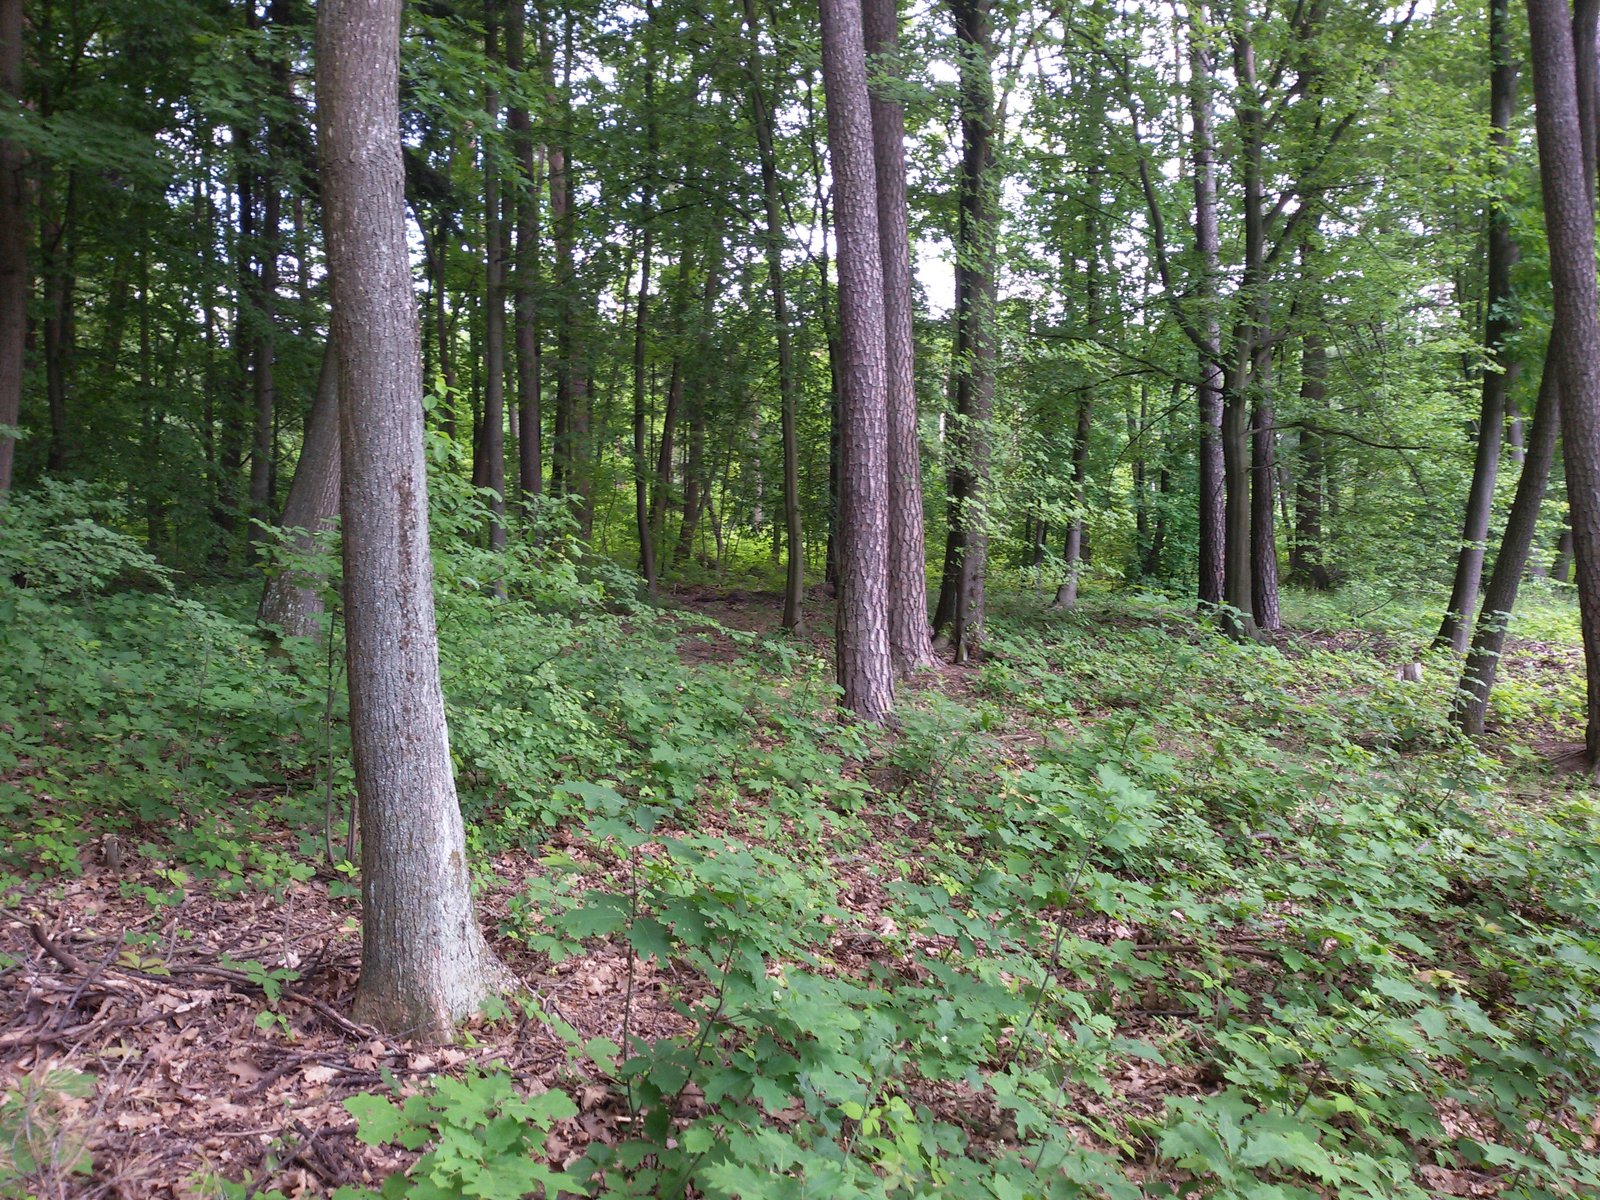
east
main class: Woodland
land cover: Pine dominated mixed woodland
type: hemiboreal forest and nemoral coniferous forest and mixed broadleaved-coniferous forest
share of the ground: 50 - 75 %
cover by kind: coniferous forest trees 35 %, broadleaved forest trees 35 %, shrubs 10 %, herbaceous plants 10 %, unconsolidated bare surface 10 %
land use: Forestry
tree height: > 5 m
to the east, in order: Pine dominated mixed woodland; Electric lines; Grass margins; Paved roads, cycling and walking lanes; Lines of trees; Fences; Grassland without tree/shrub cover; Fences; Pine dominated mixed woodland; Artificial constructions in urban areas; Other mixed woodland; Tracks; Grass margins; Tracks; Pine dominated mixed woodland
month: June
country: PL
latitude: 50.1058
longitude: 21.5299
